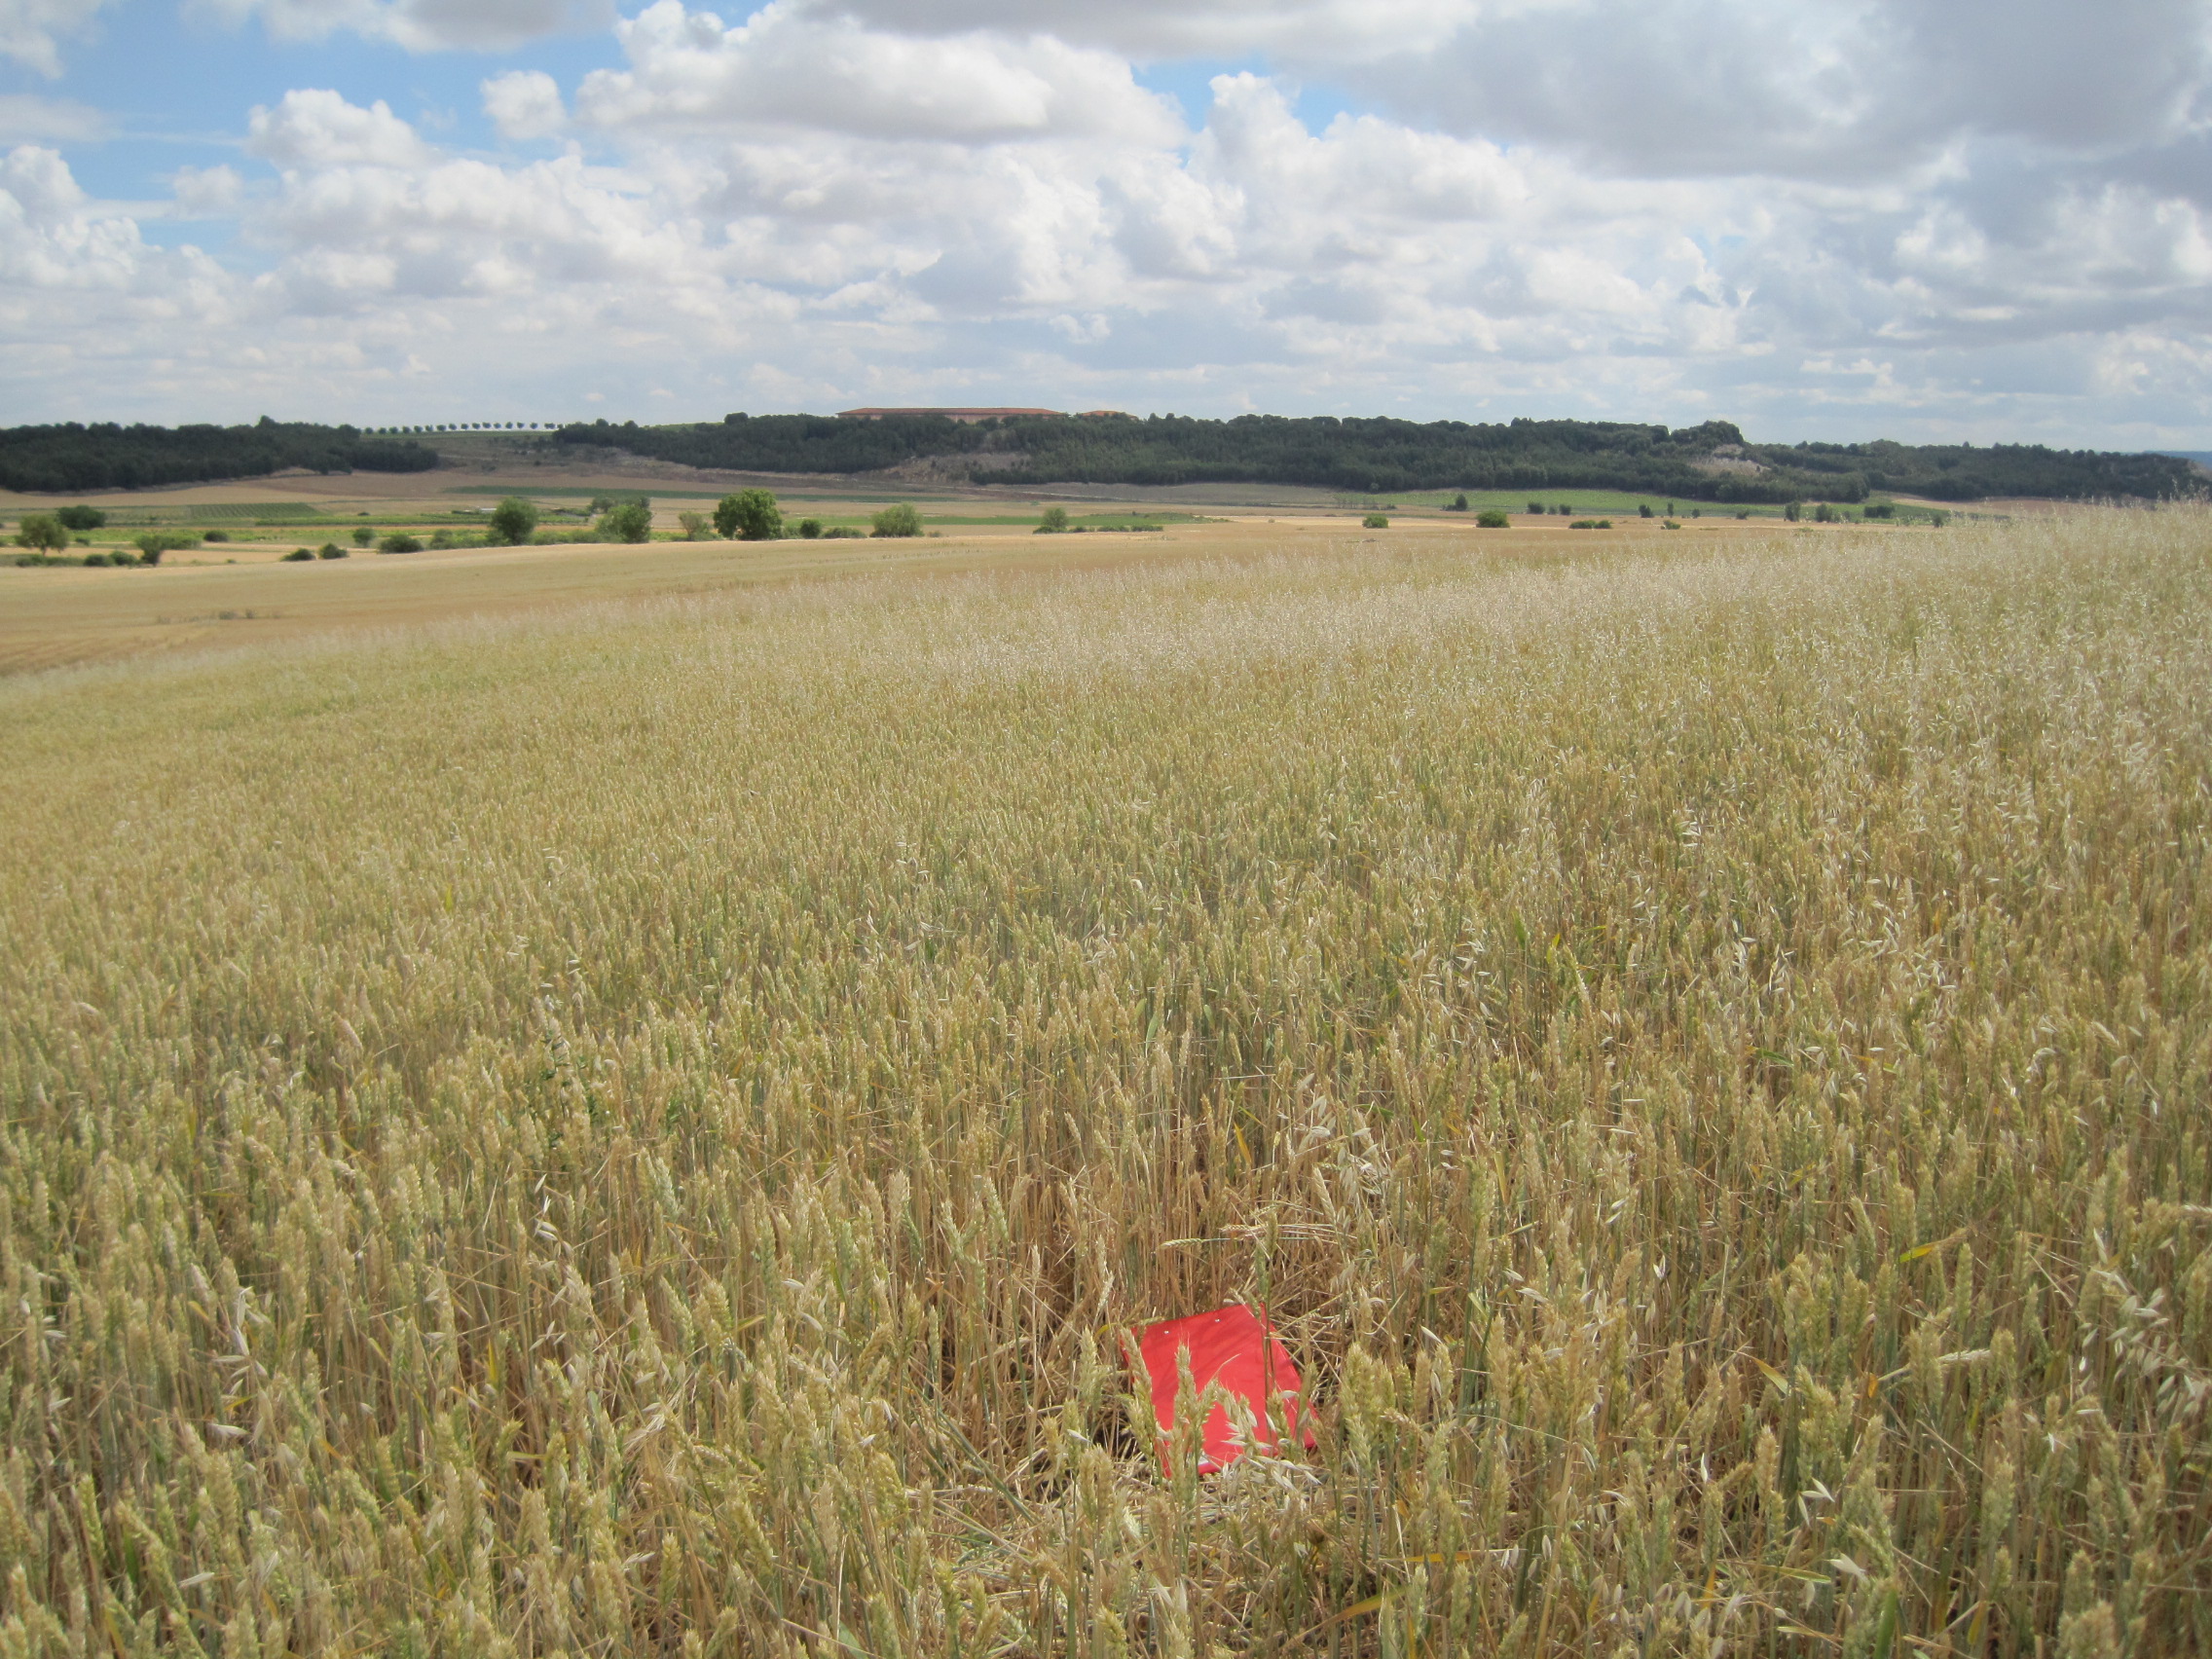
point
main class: Cropland
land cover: Common wheat
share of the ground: > 75 %
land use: Agriculture (excluding fallow land and kitchen gardens)
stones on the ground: 10 - 25 %
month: June
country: ES
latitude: 41.7747
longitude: -4.7115
